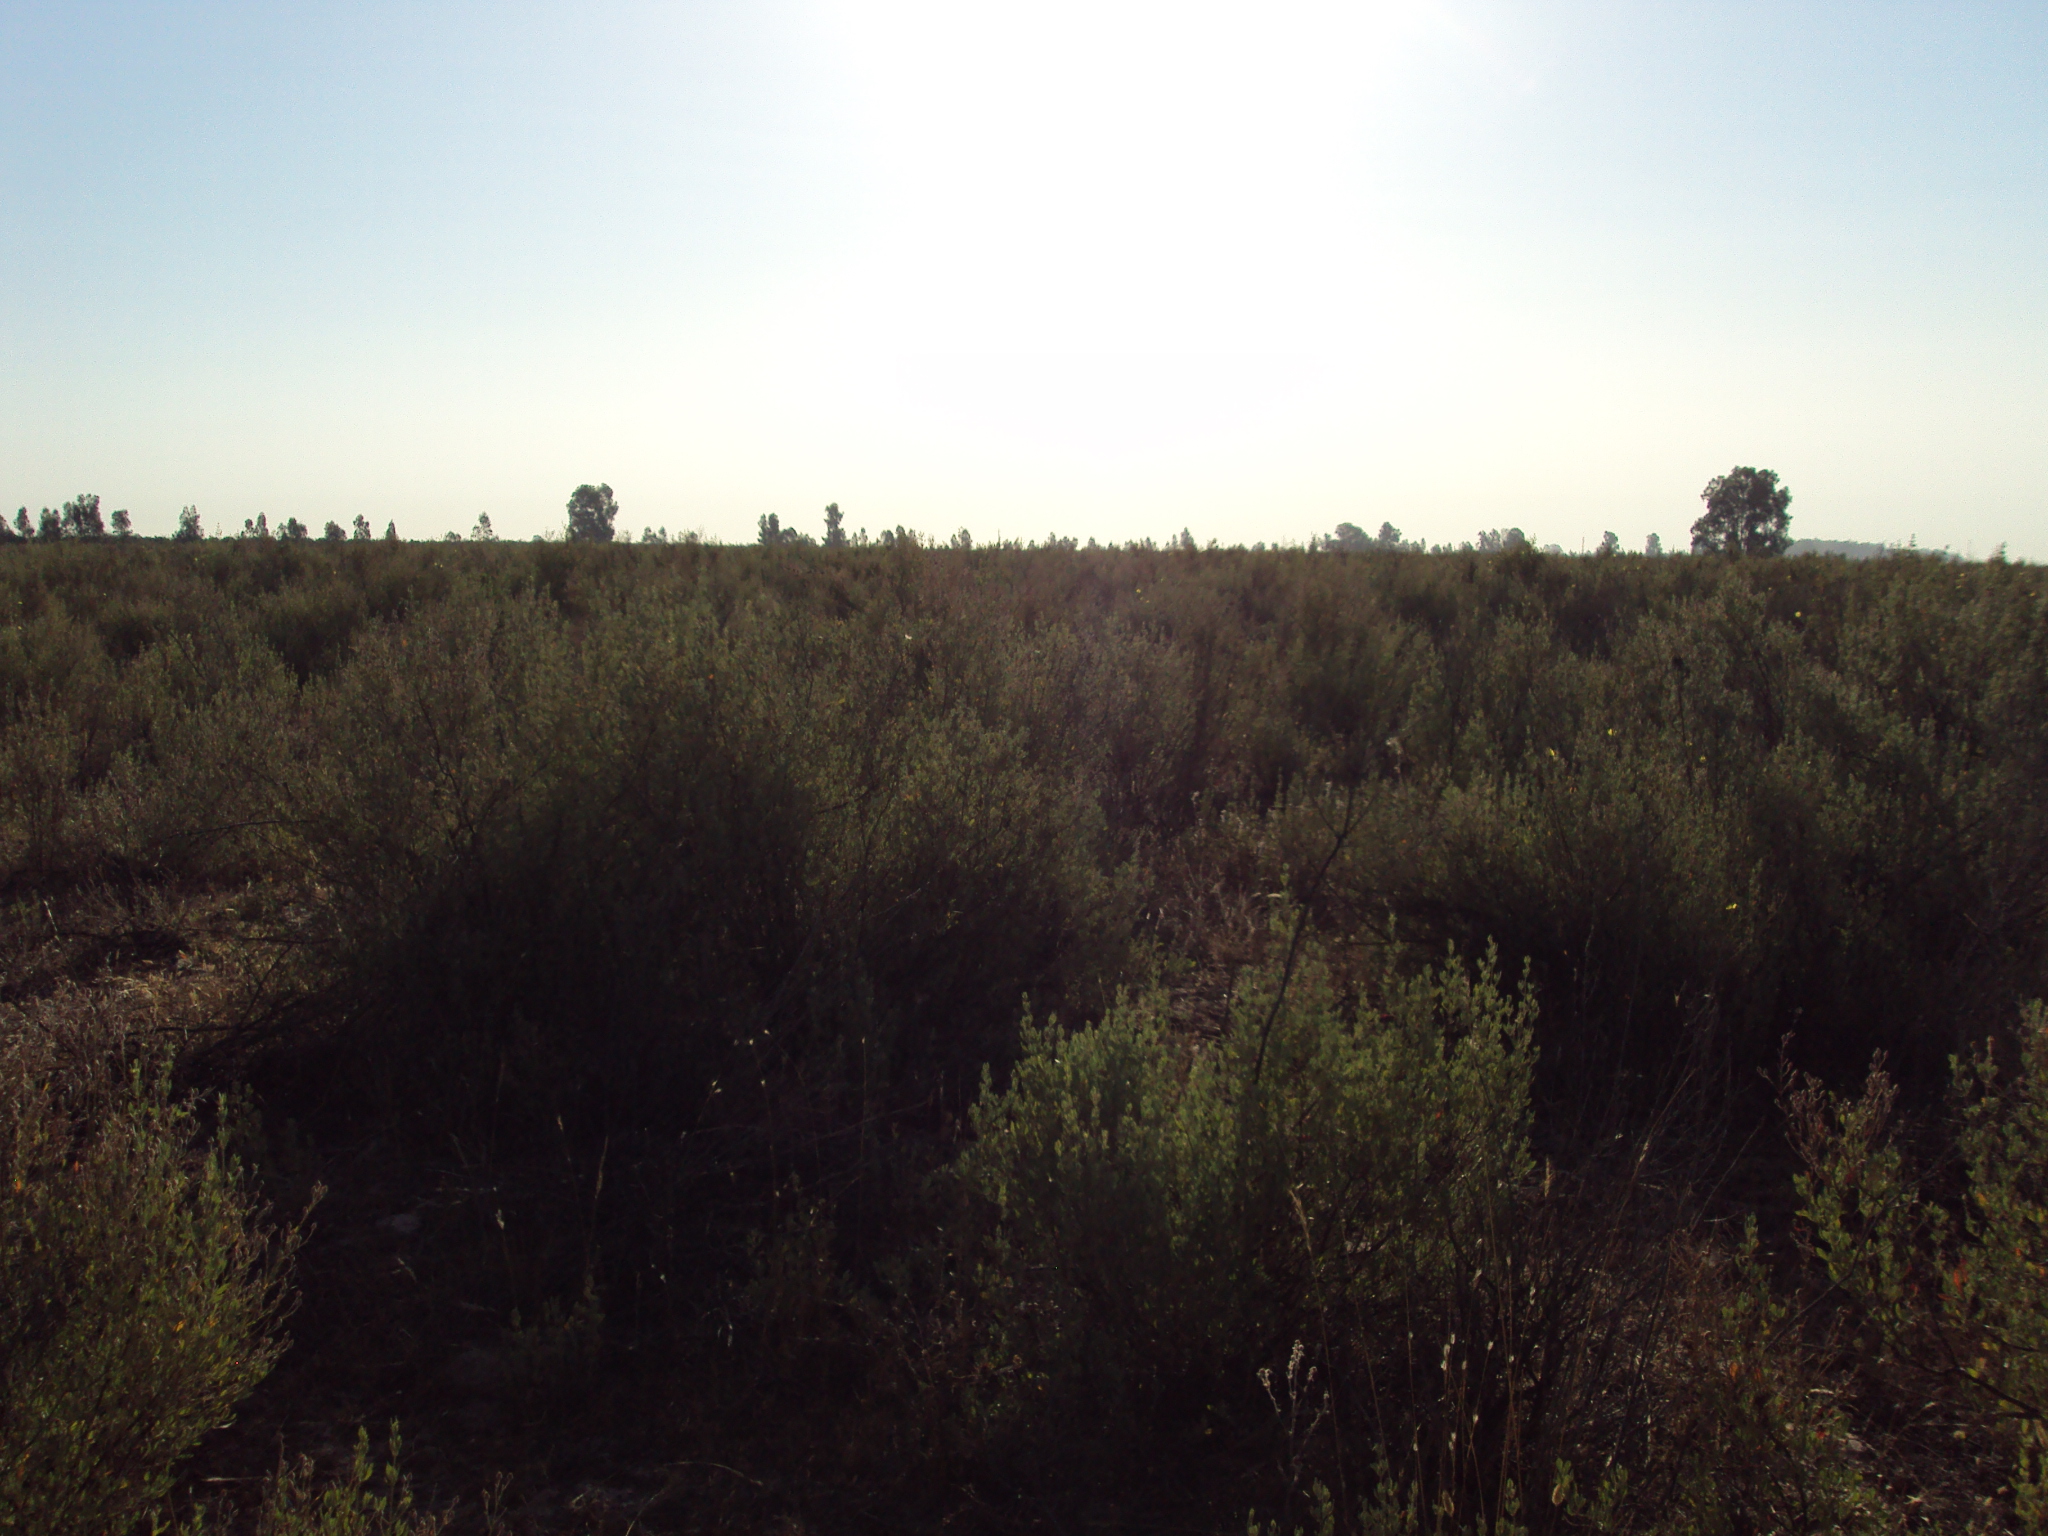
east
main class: Shrubland
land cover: Shrubland without tree cover
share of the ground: > 75 %
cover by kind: shrubs 80 %, herbaceous plants 20 %
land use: Agriculture (excluding fallow land and kitchen gardens)
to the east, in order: Shrubland without tree cover
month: July
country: ES
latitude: 37.0977
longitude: -6.5560
